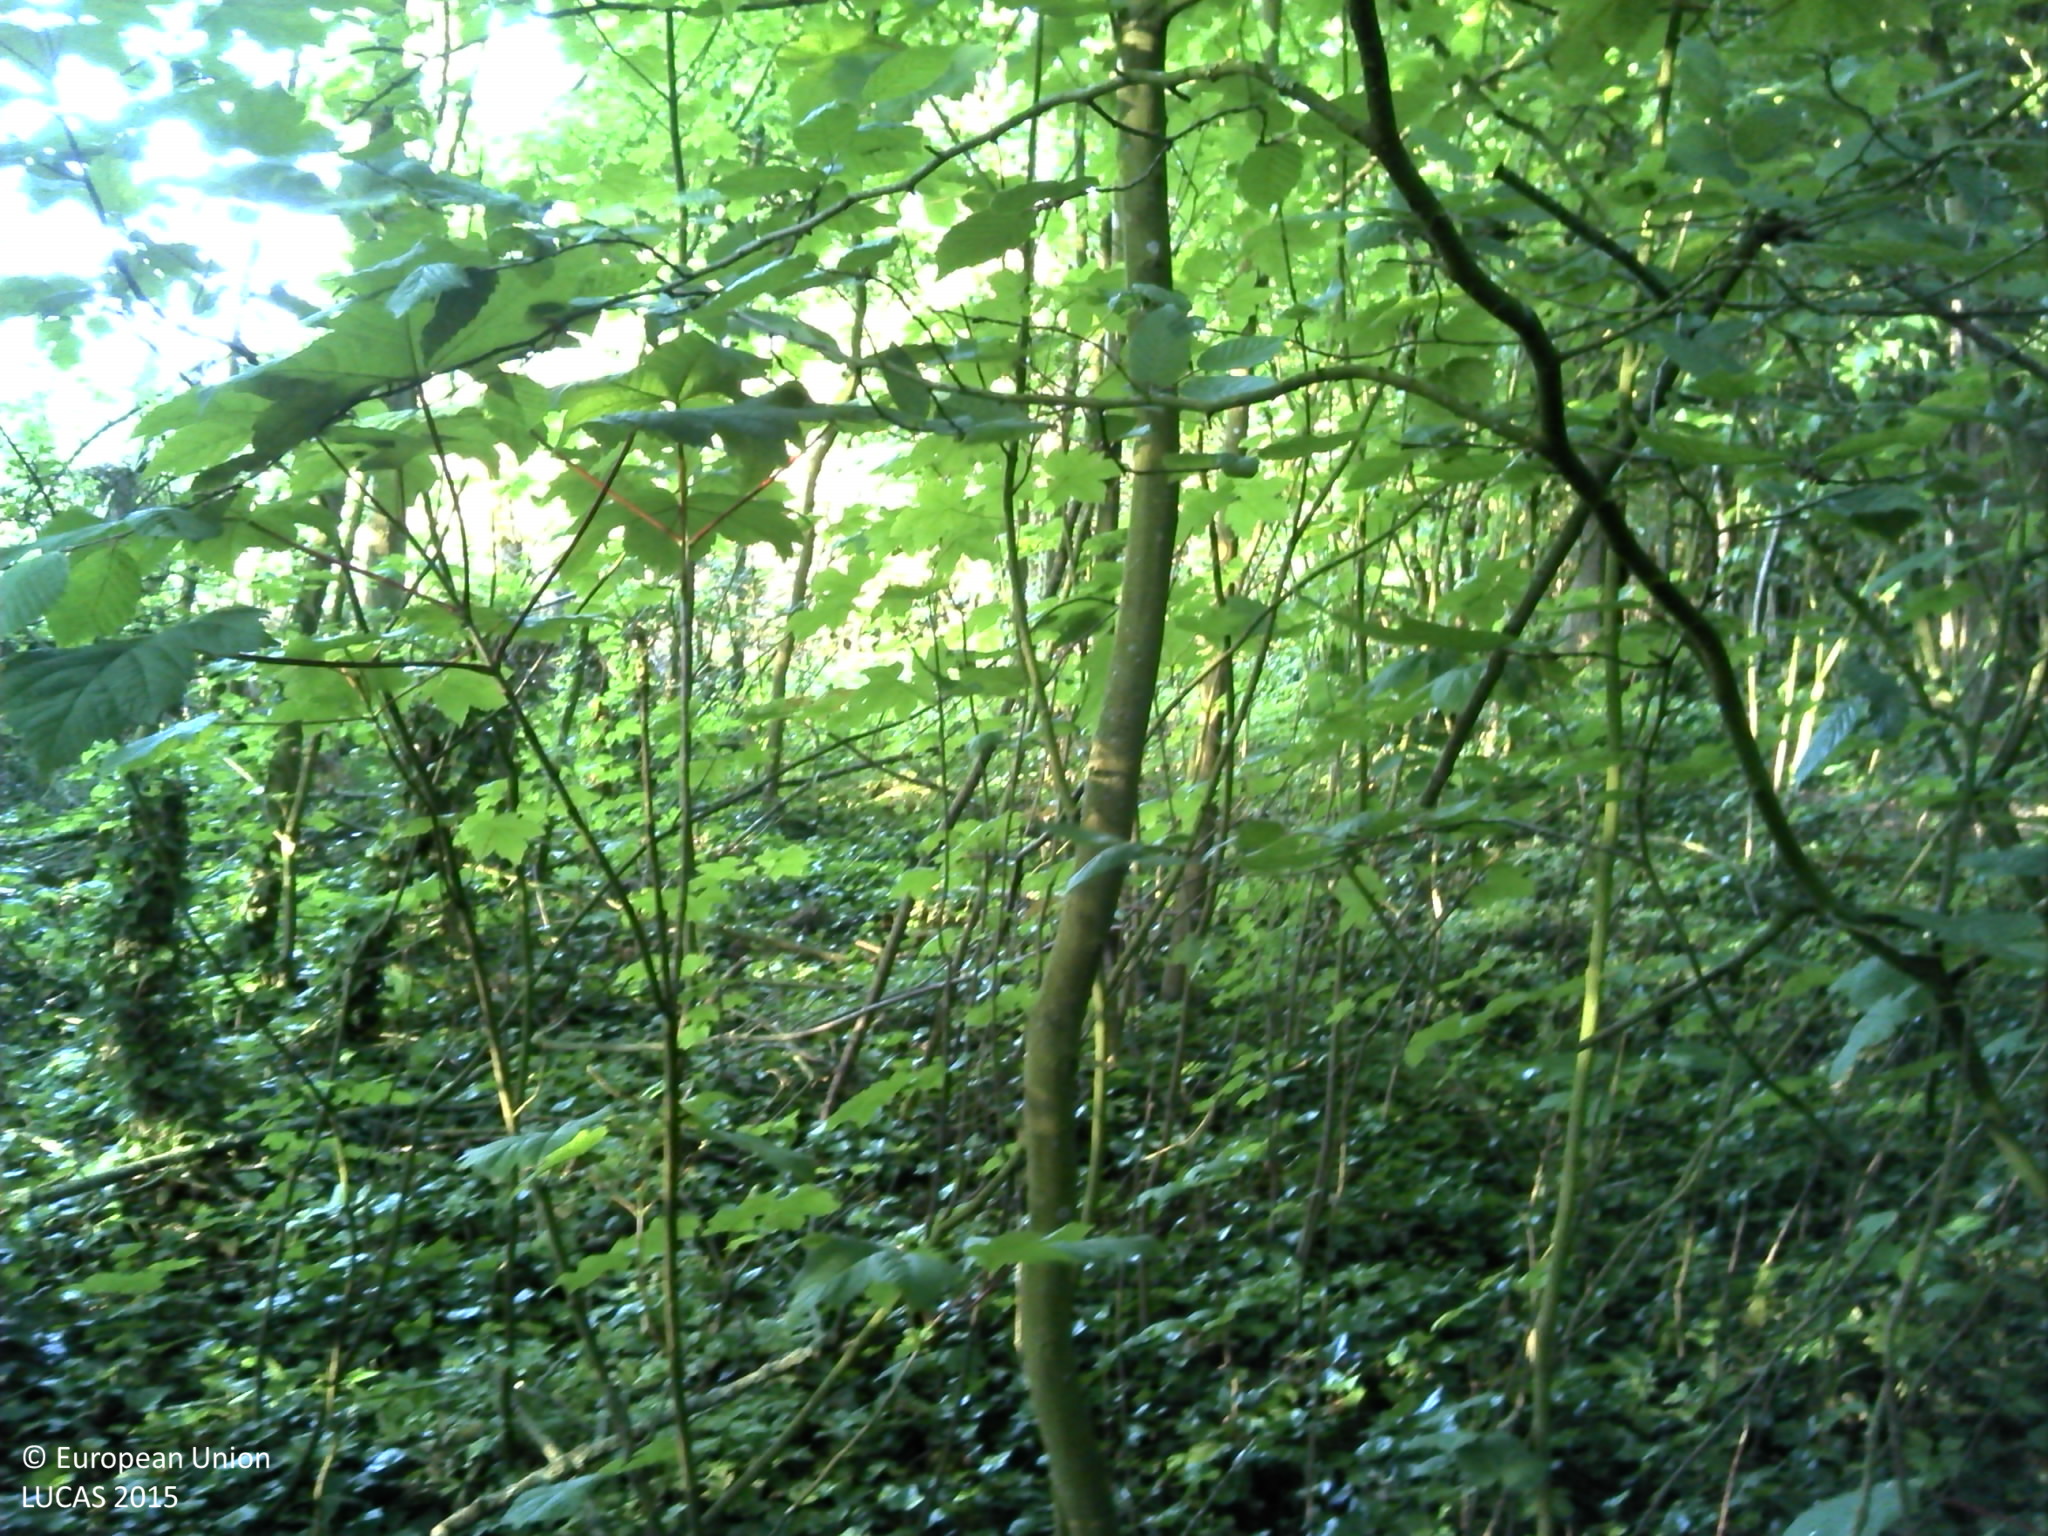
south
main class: Woodland
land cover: Broadleaved woodland
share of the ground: > 75 %
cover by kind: broadleaved forest trees 80 %, herbaceous plants 20 %
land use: Forestry
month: June
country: FR
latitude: 49.6746
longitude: 1.1235
